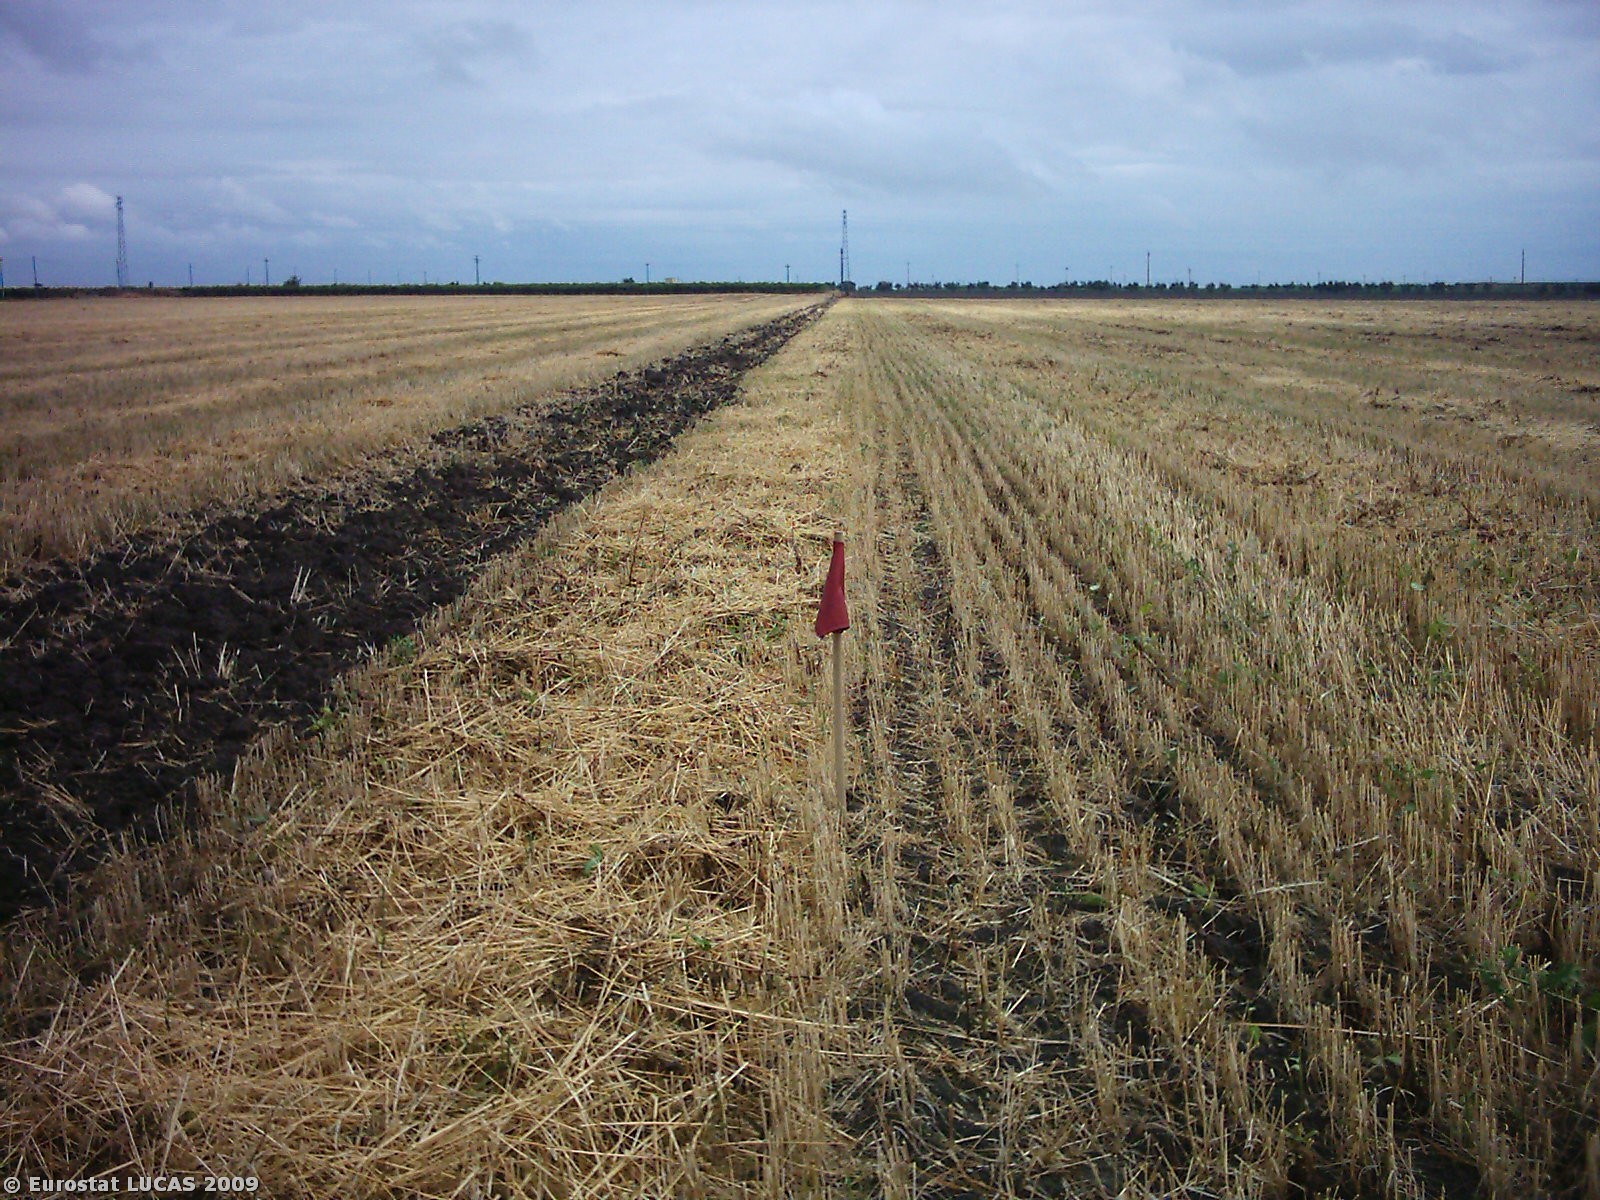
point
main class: Cropland
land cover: Durum wheat
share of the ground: > 75 %
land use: Agriculture (excluding fallow land and kitchen gardens)
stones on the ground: < 10 %
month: June
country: IT
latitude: 41.4256
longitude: 15.6893
